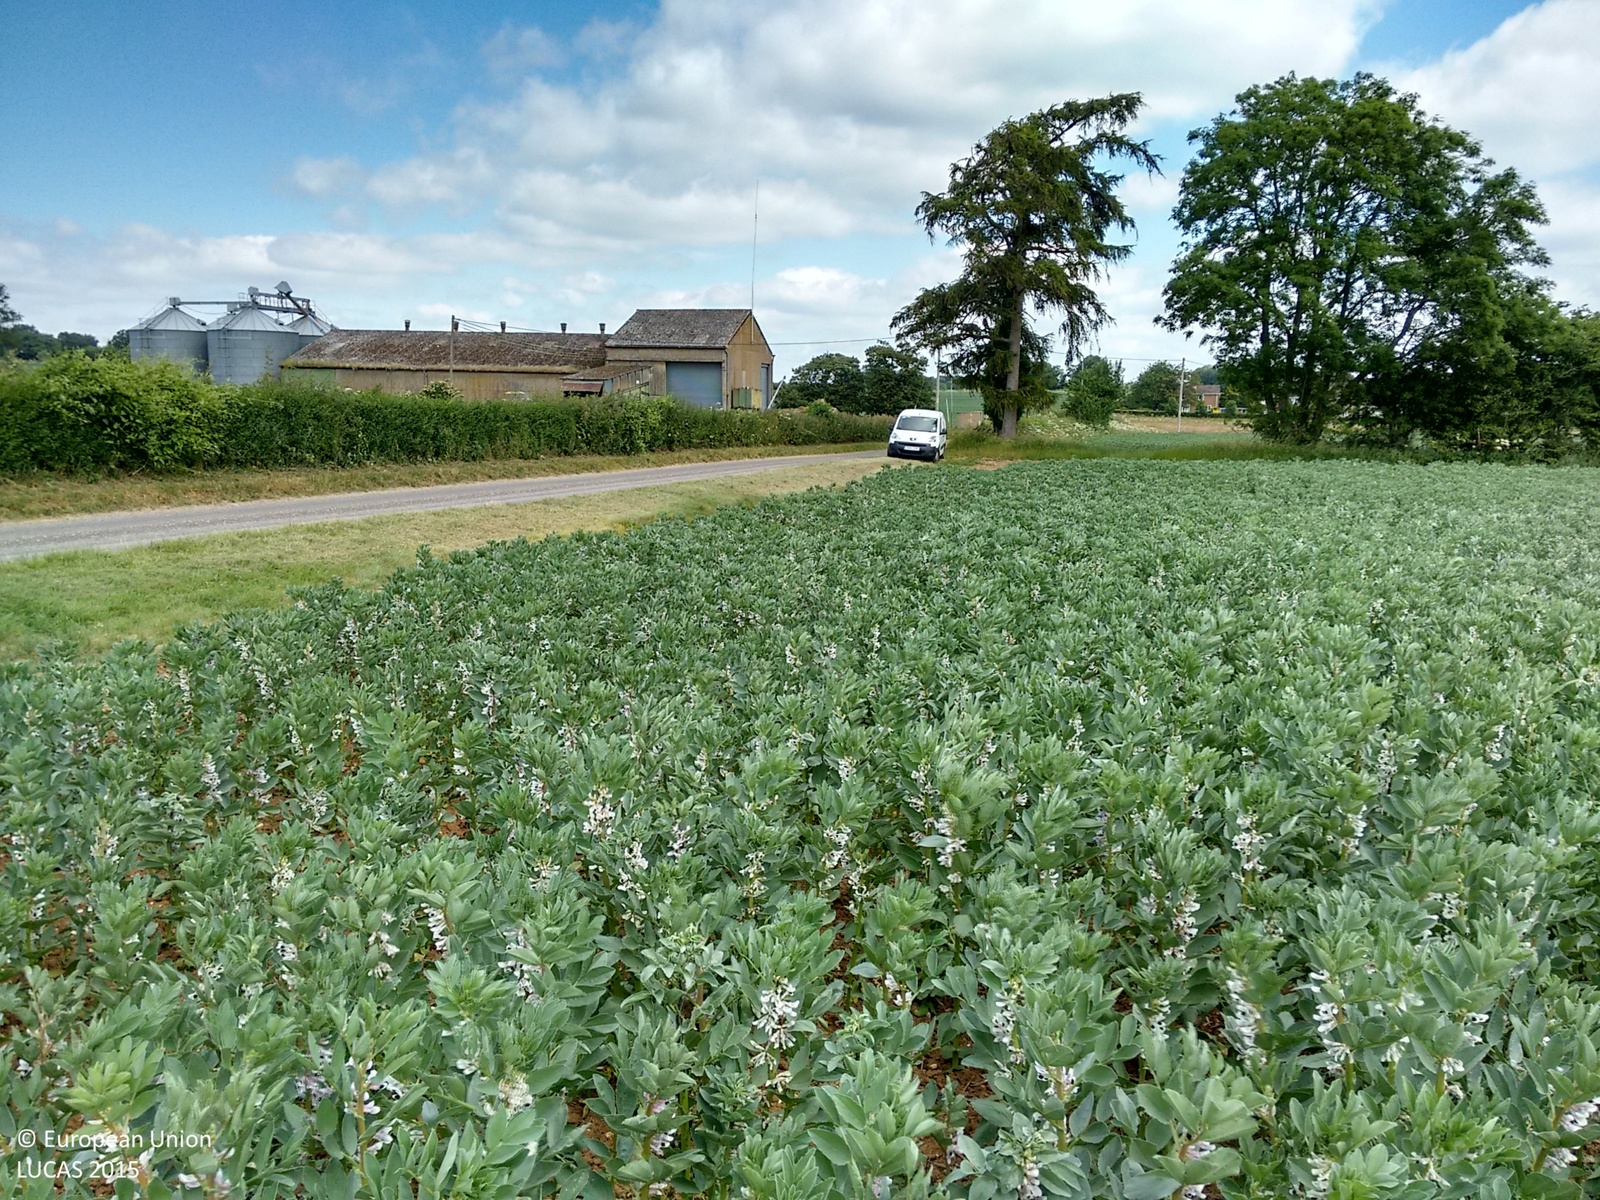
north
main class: Cropland
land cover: Dry pulses
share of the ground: > 75 %
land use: Agriculture (excluding fallow land and kitchen gardens)
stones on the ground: 10 - 25 %
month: June
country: GB
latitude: 51.3979
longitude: -1.5068
